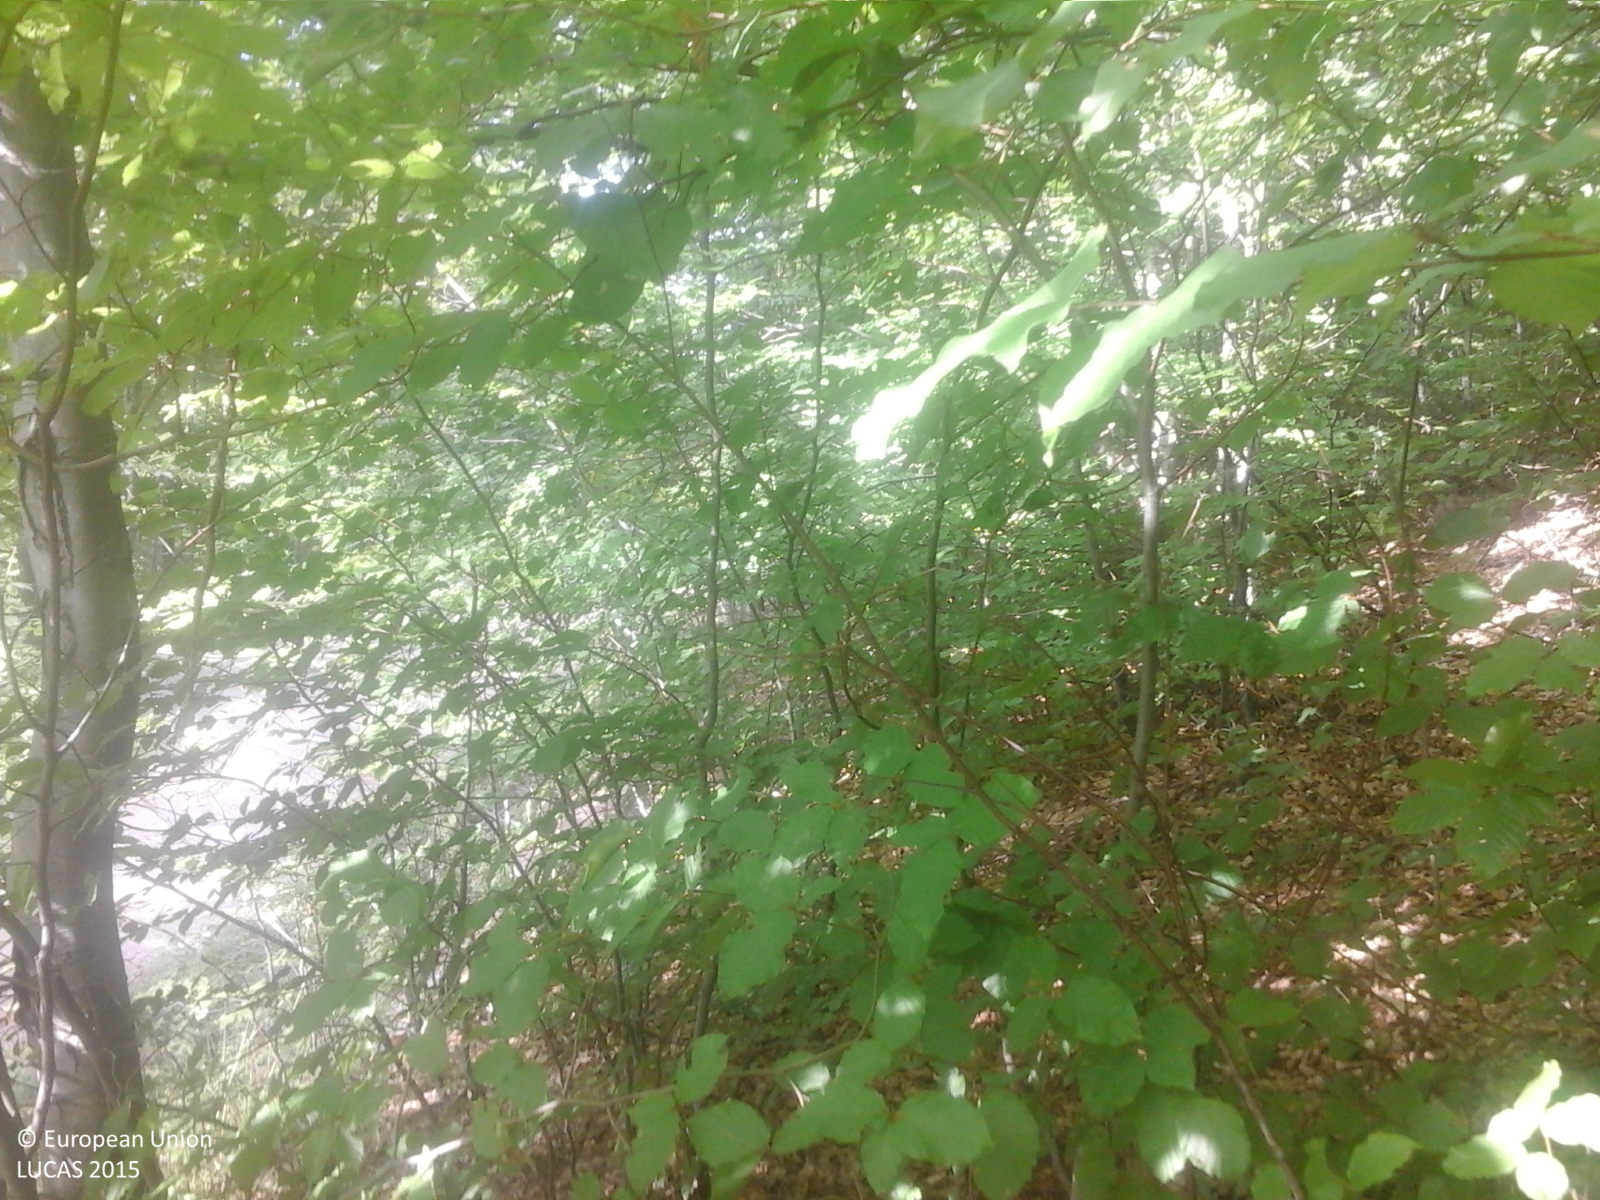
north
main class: Woodland
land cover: Broadleaved woodland
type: beech forest
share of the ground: > 75 %
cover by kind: broadleaved forest trees 100 %
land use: Forestry
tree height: > 5 m
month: September
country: RO
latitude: 46.9674
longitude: 22.7677
